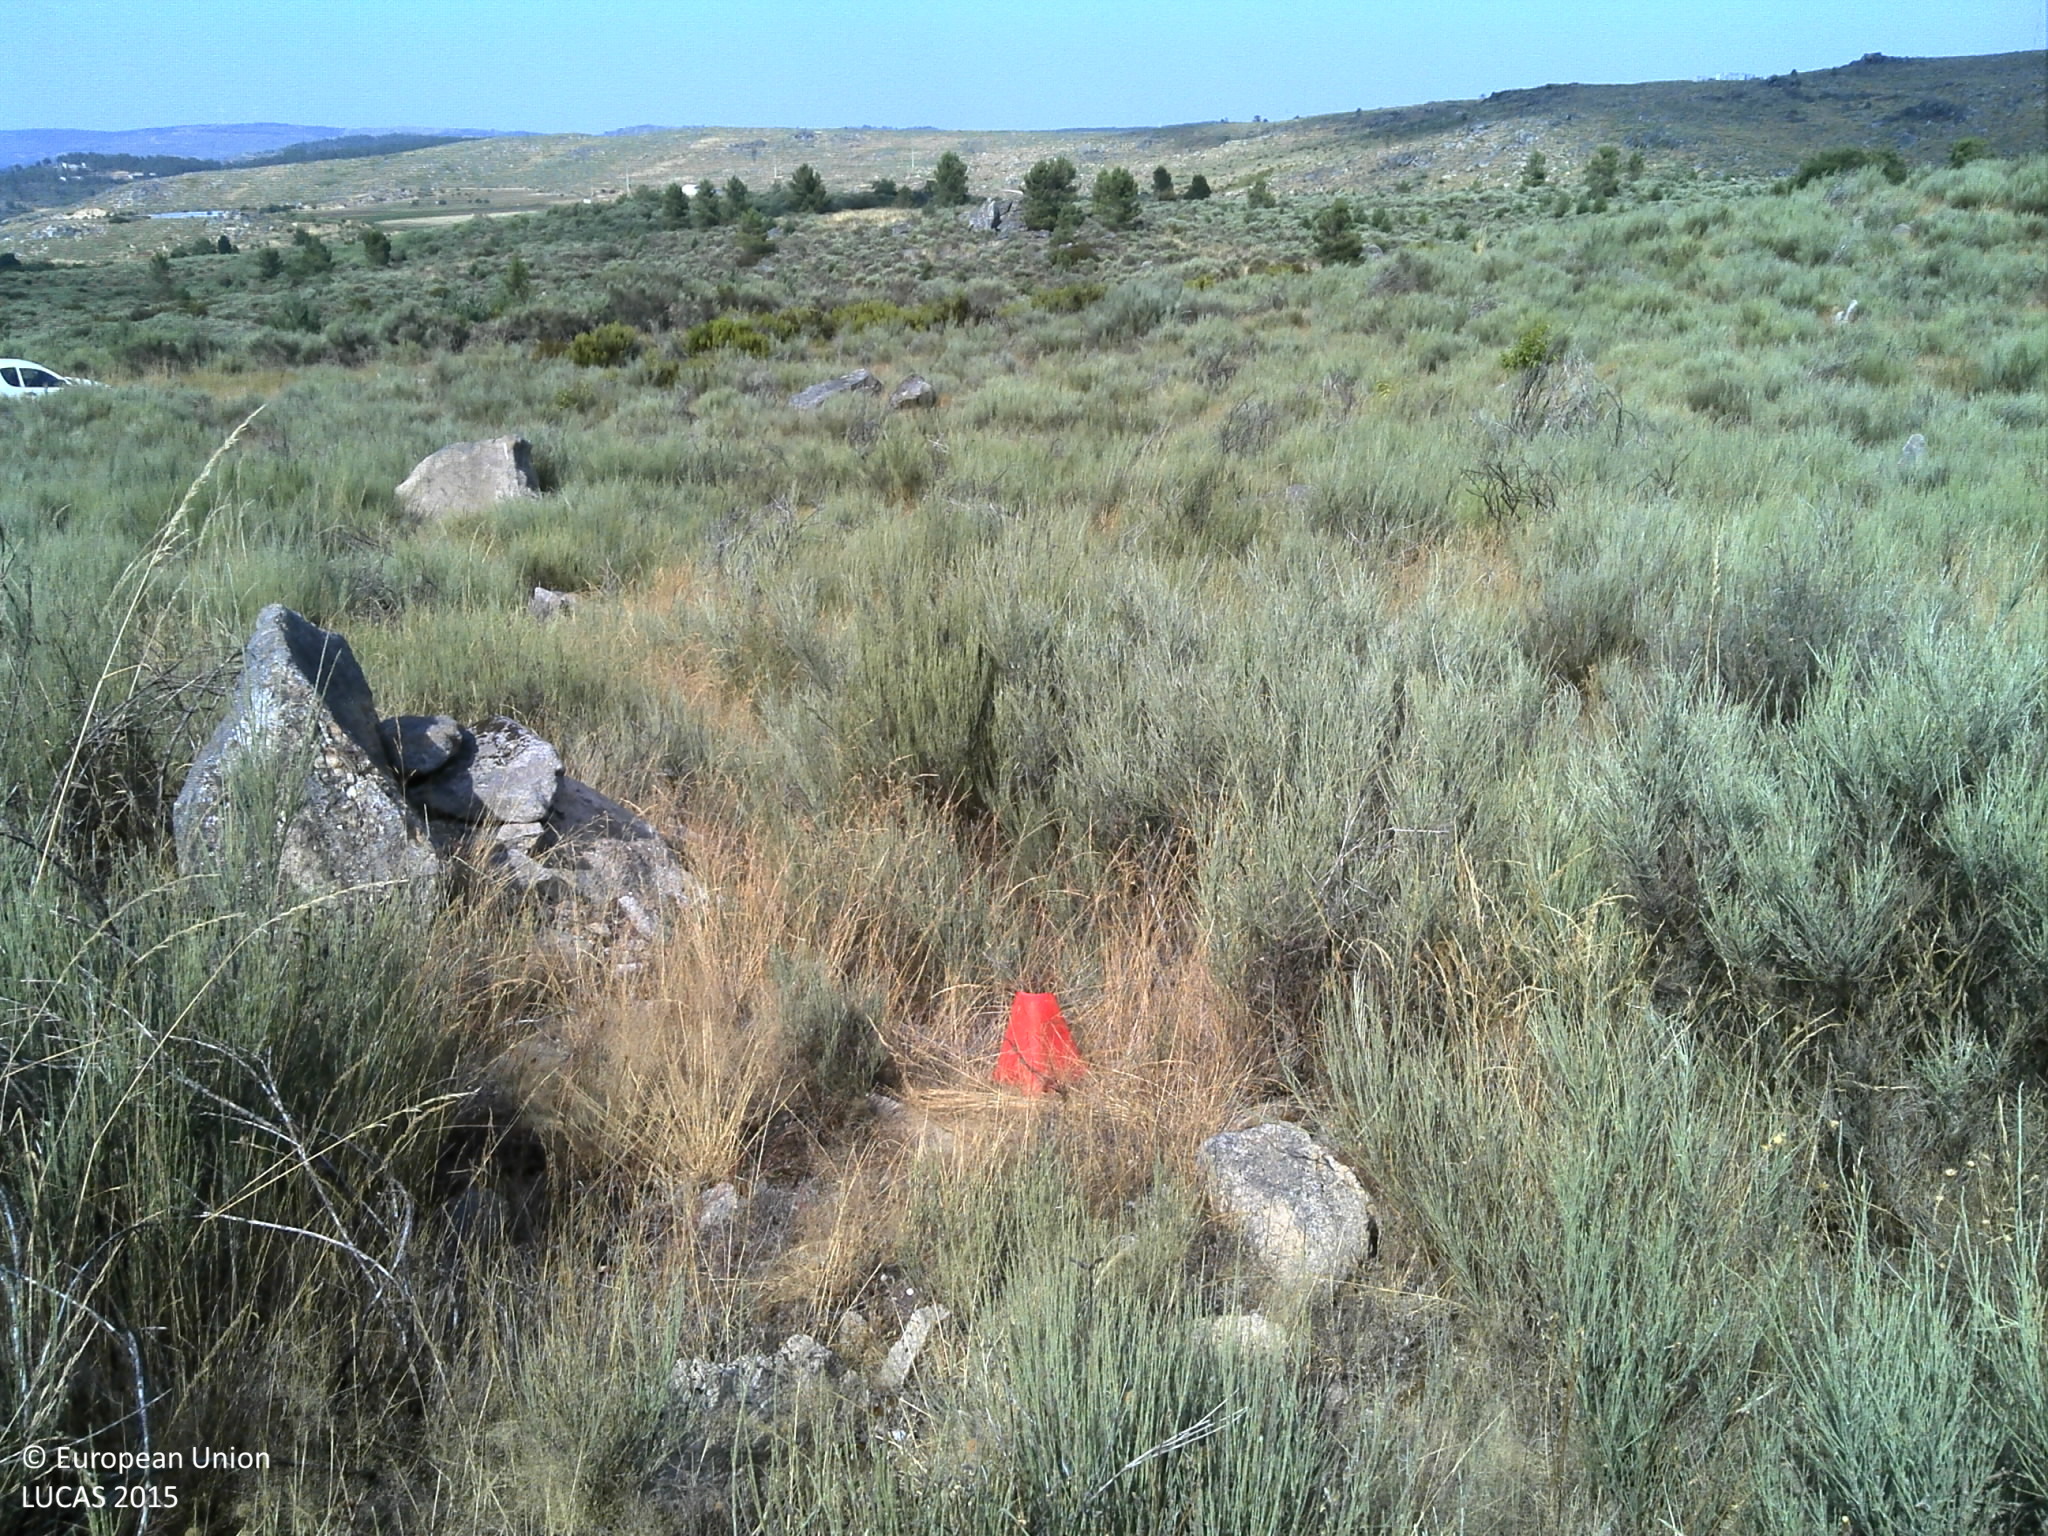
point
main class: Shrubland
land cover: Shrubland without tree cover
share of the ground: 50 - 75 %
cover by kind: shrubs 50 %, consolidated bare surface 20 %, herbaceous plants 15 %, unconsolidated bare surface 15 %
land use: Semi-natural and natural areas not in use
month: July
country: PT
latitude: 40.8806
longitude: -7.4783
